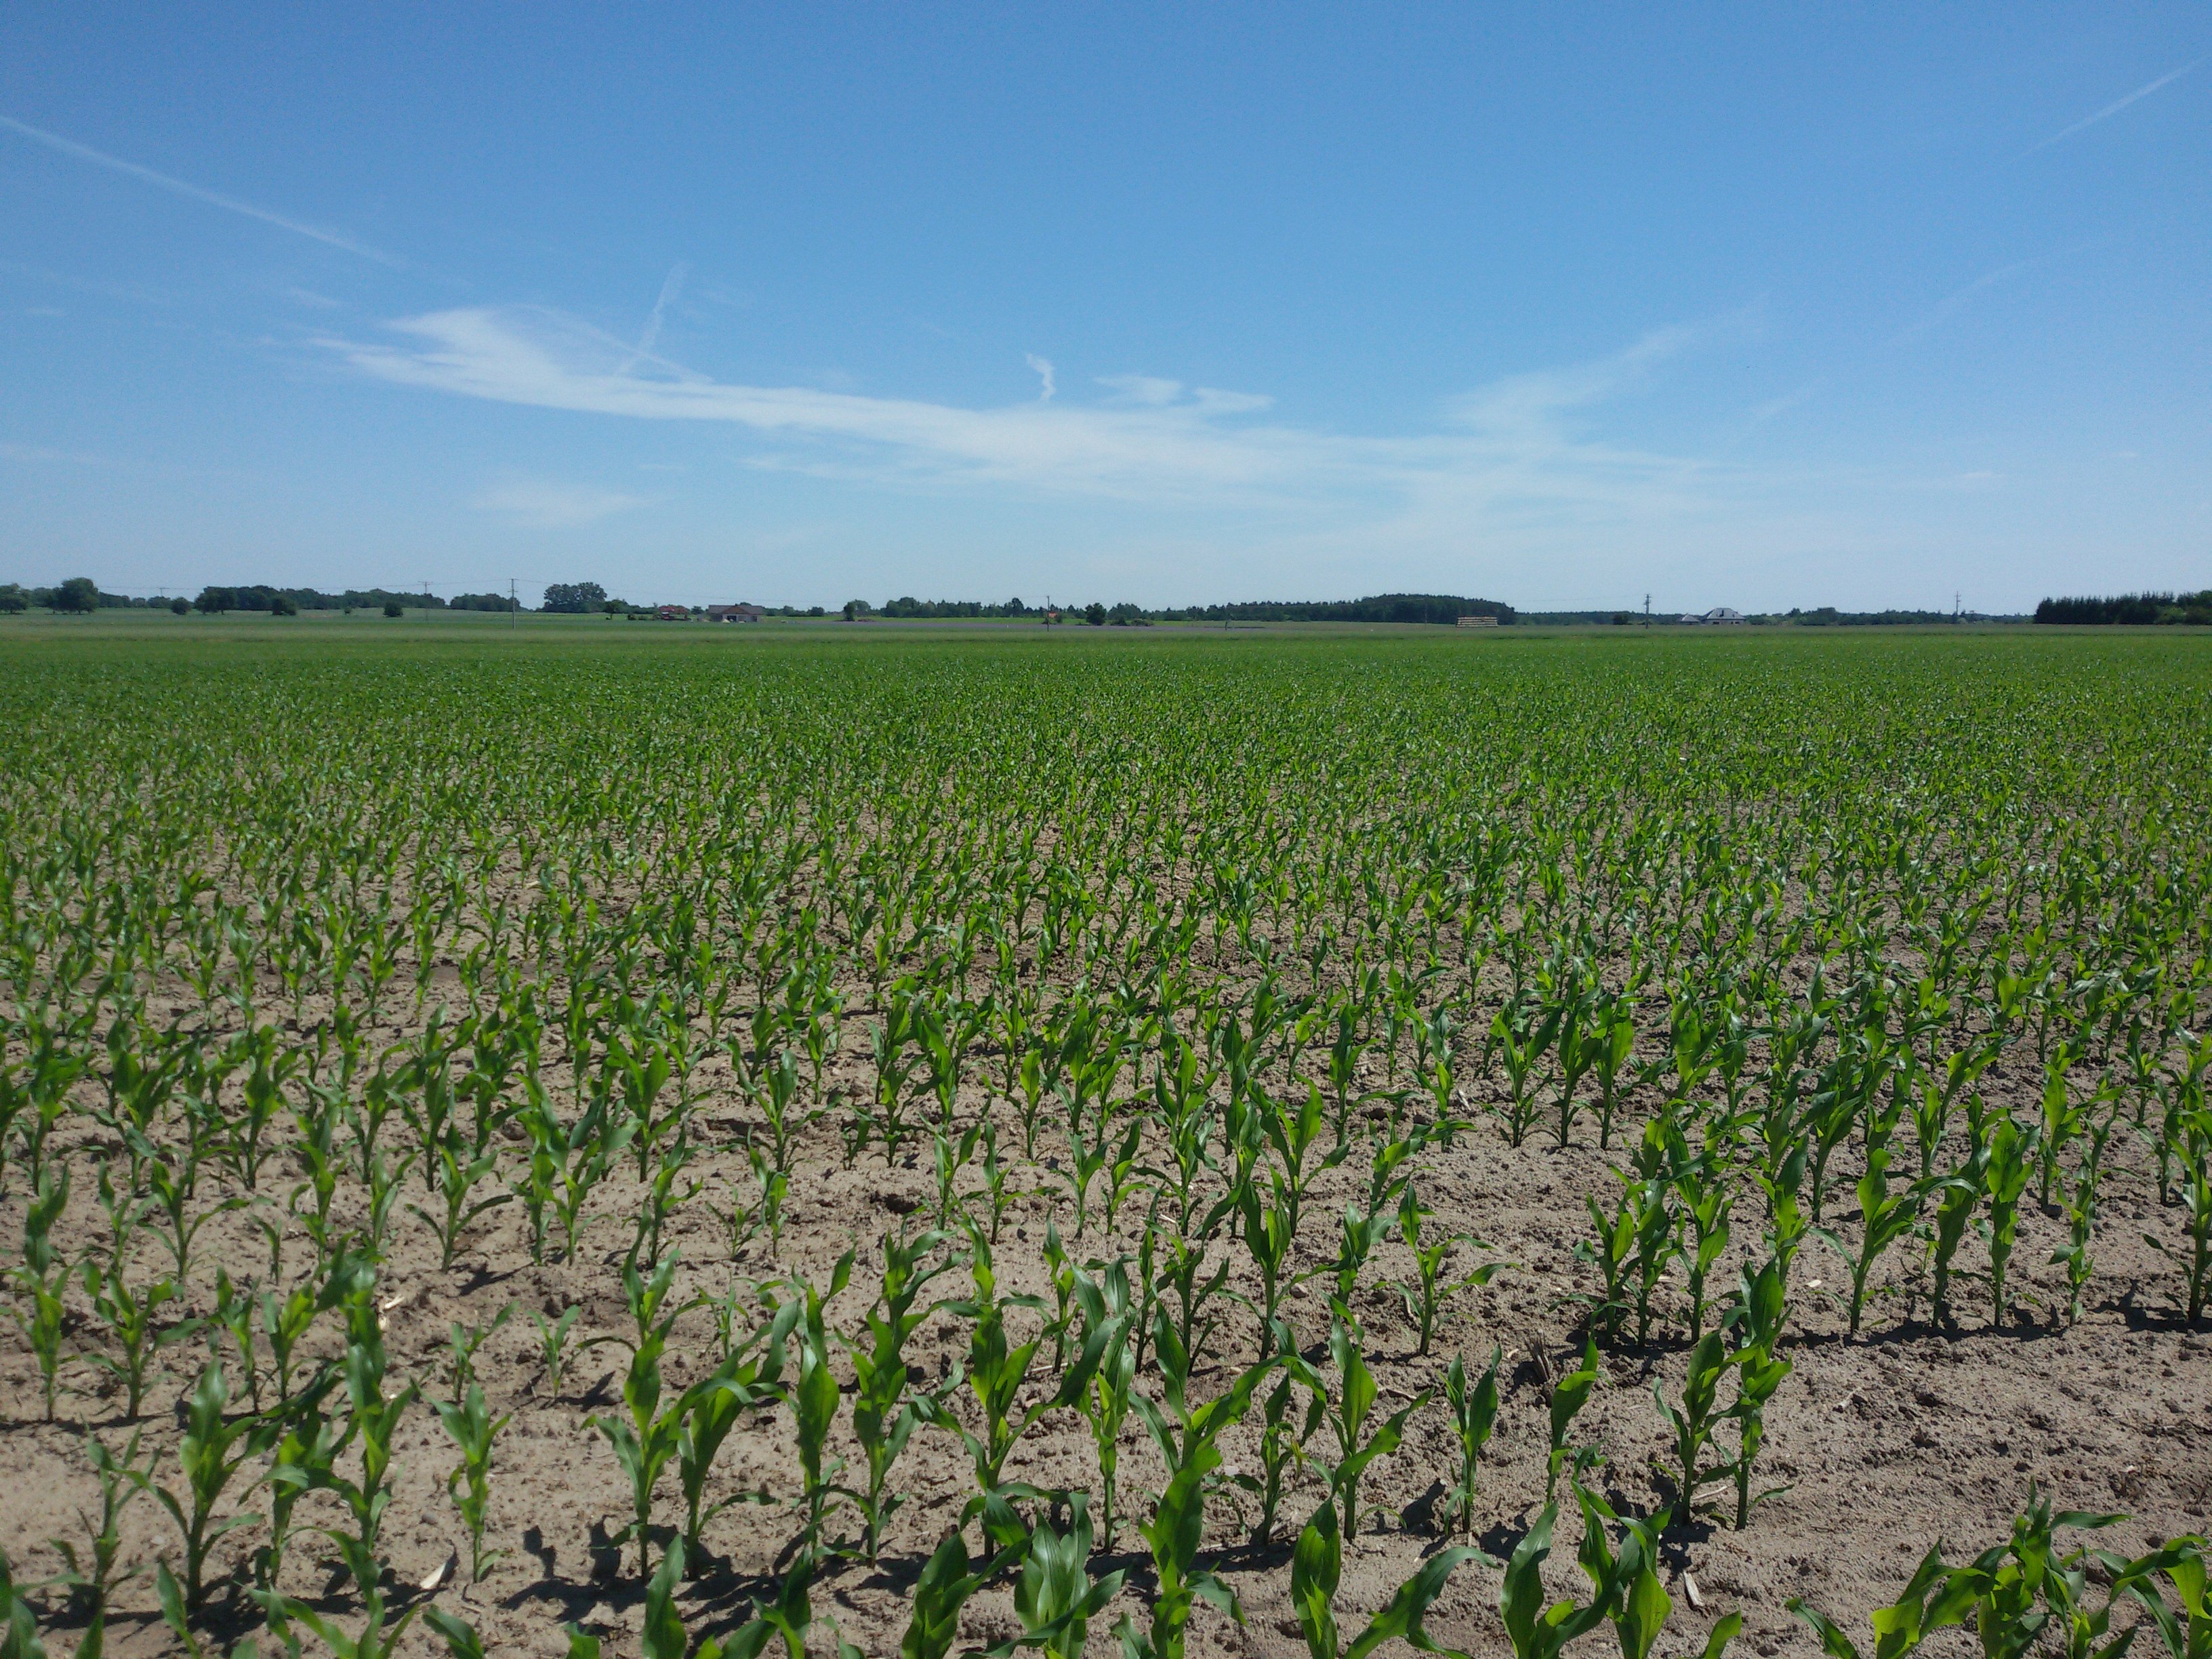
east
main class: Cropland
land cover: Maize
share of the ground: 25 - 50 %
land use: Agriculture (excluding fallow land and kitchen gardens)
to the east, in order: Maize
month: June
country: PL
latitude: 52.4847
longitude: 17.1821
